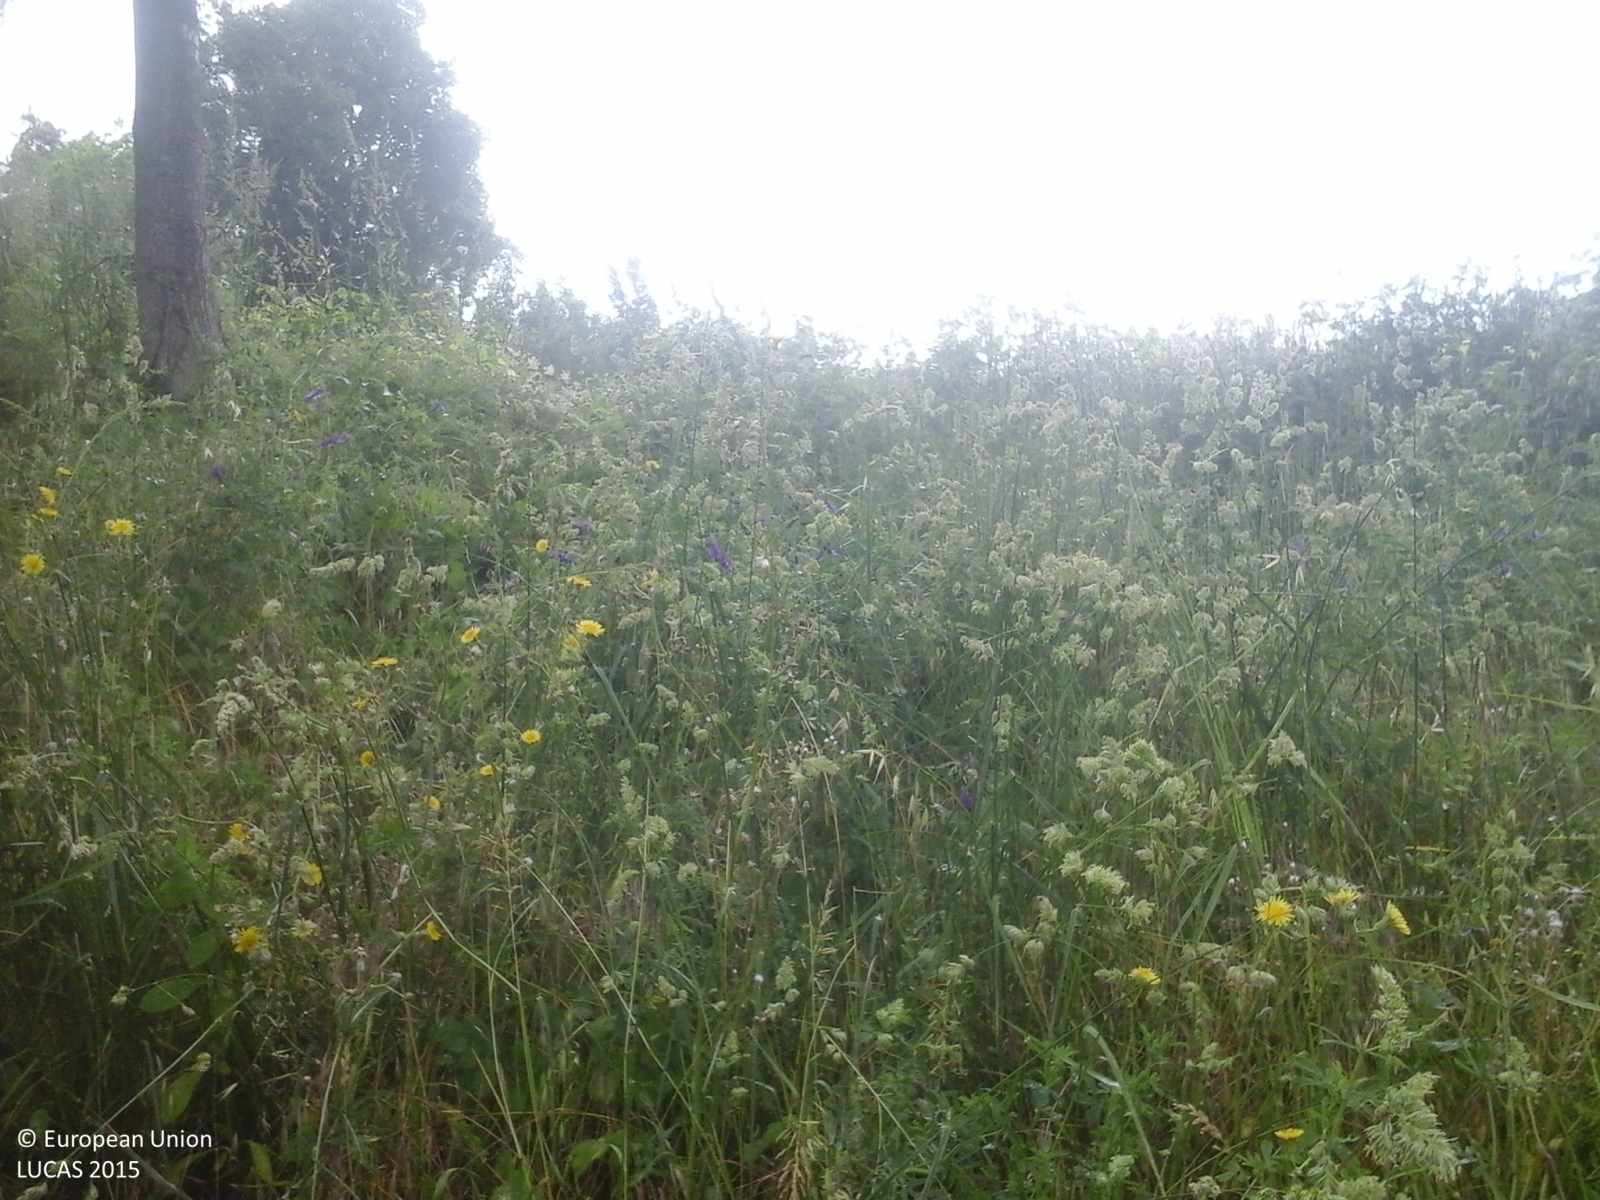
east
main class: Cropland
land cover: Lucerne
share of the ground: > 75 %
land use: Agriculture (excluding fallow land and kitchen gardens)
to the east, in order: Lucerne; Lines of trees; Paved roads, cycling and walking lanes; Lucerne; Broadleaved woodland; Electric lines; Broadleaved woodland; Electric lines; Lucerne
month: May
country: IT
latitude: 44.2744
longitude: 10.9125
